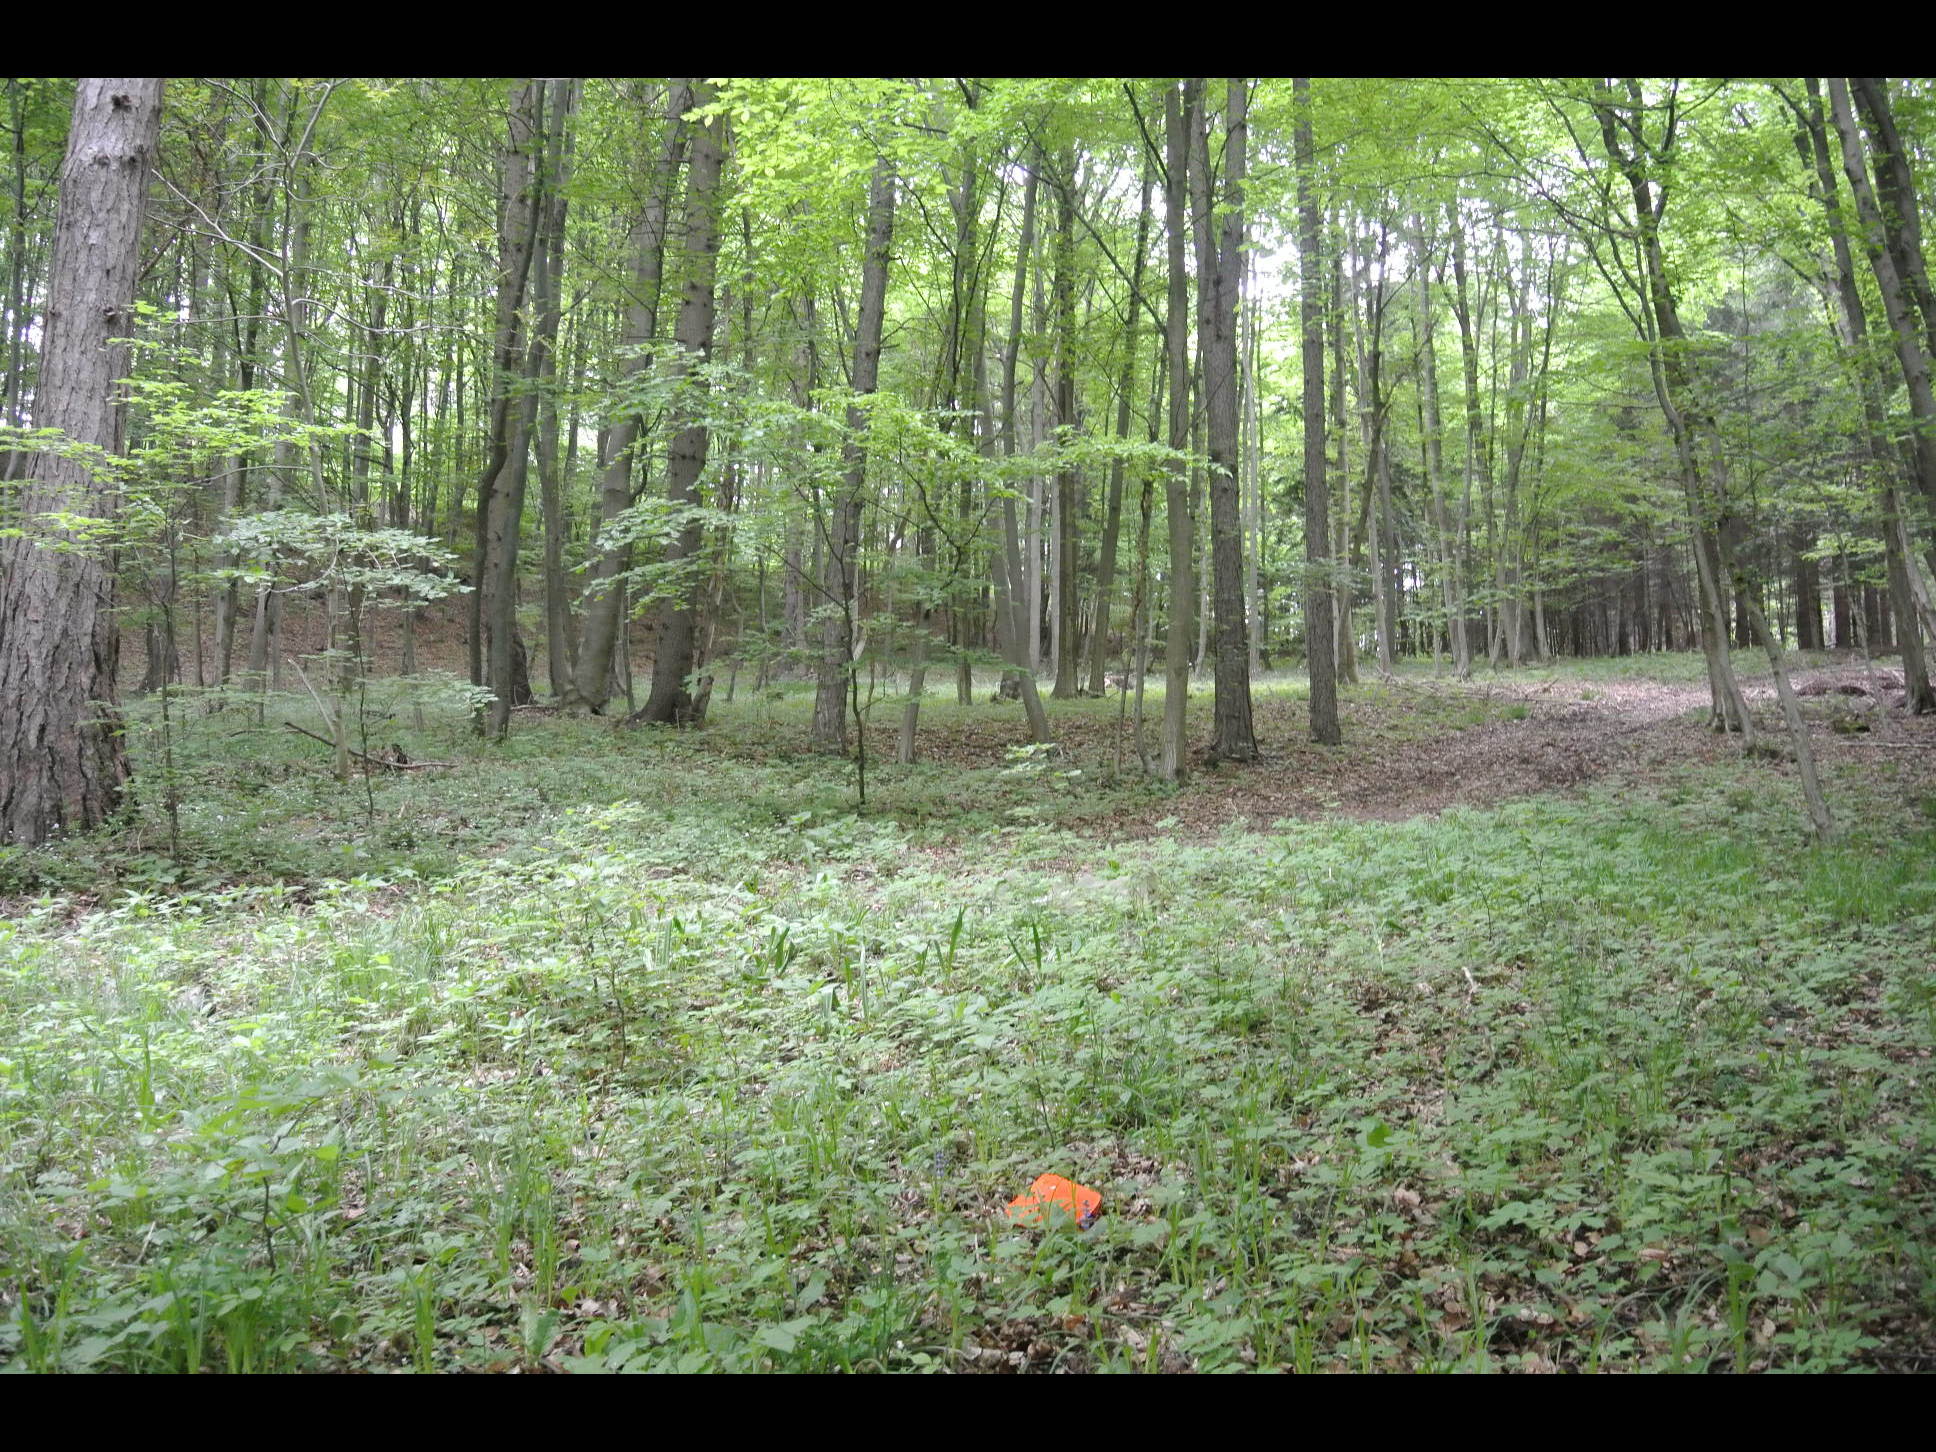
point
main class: Woodland
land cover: Broadleaved woodland
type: beech forest
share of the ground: > 75 %
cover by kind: broadleaved forest trees 80 %, coniferous forest trees 20 %
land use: Forestry
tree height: > 5 m
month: May
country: AT
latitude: 47.9839
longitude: 16.0730
